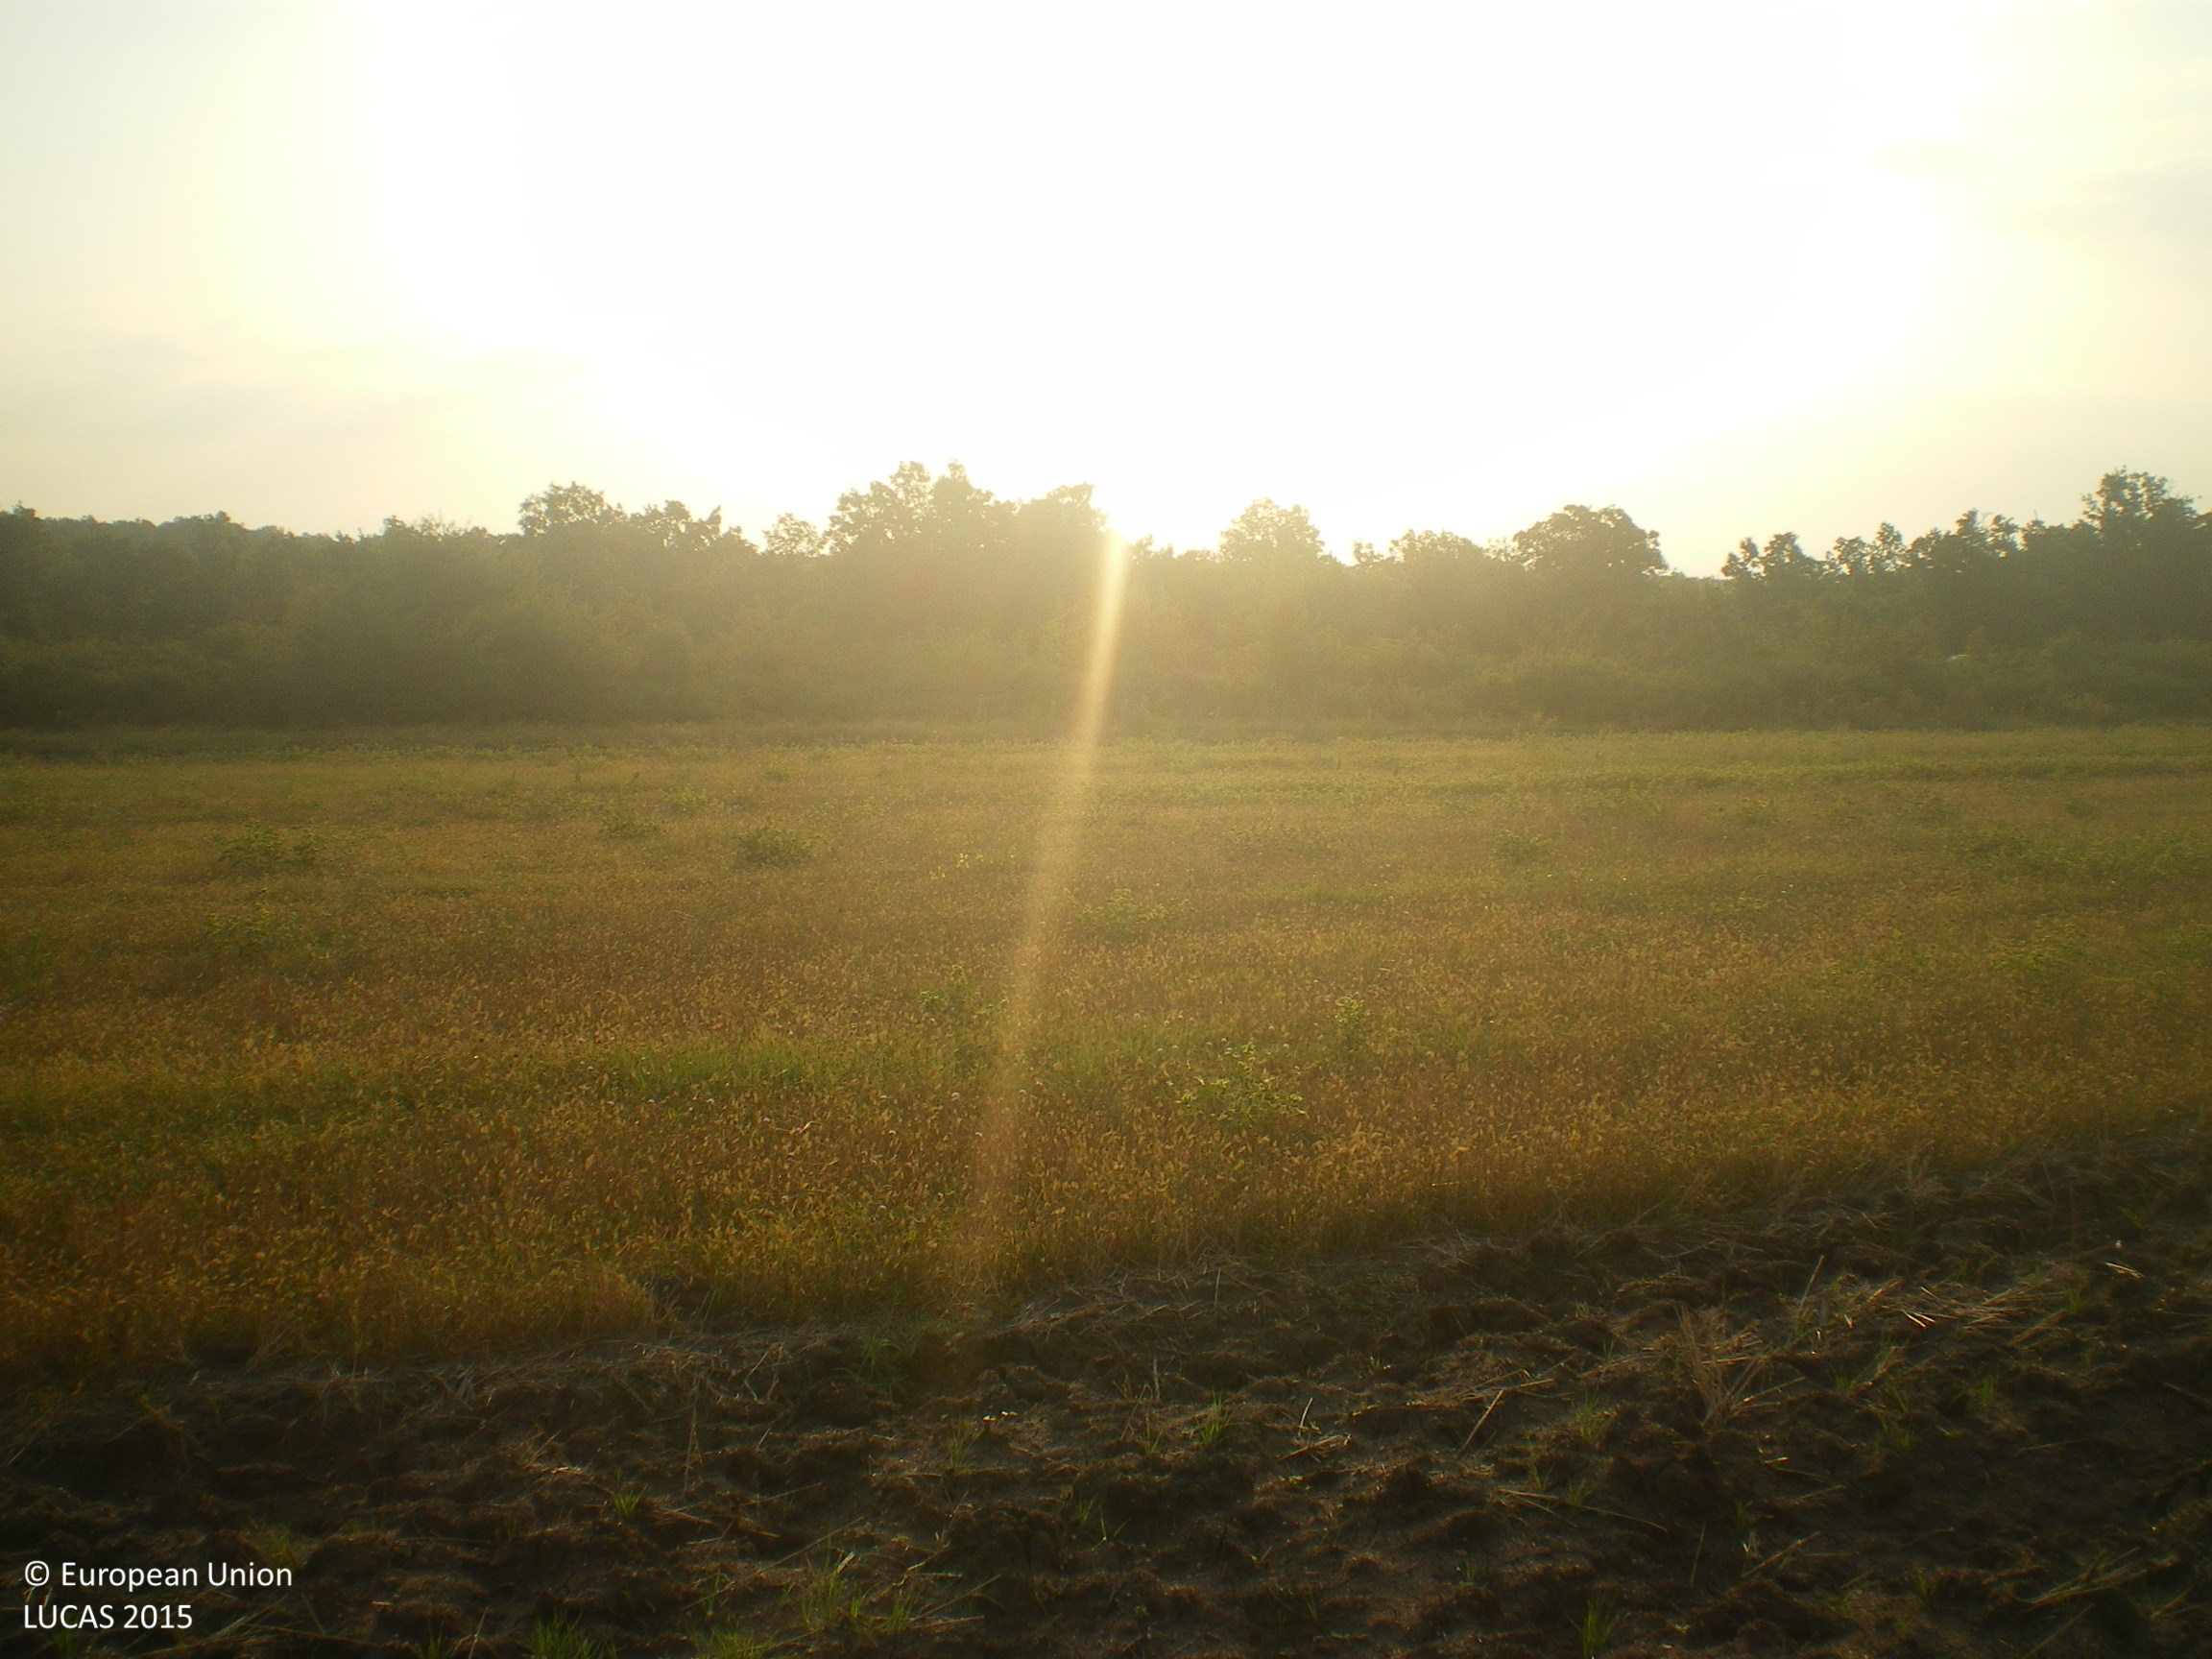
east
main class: Woodland
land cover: Broadleaved woodland
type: mesophytic deciduous forest
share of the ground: > 75 %
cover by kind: broadleaved forest trees 80 %, shrubs 20 %
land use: Forestry
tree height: > 5 m
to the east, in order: Broadleaved woodland; Spontaneously vegetated surfaces; Common wheat; Spontaneously vegetated surfaces; Shrubland with sparse tree cover; Grass margins; Paved roads, cycling and walking lanes; Grass margins; Shrubland with sparse tree cover; Broadleaved woodland
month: September
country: BG
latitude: 42.0669
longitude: 25.7941
